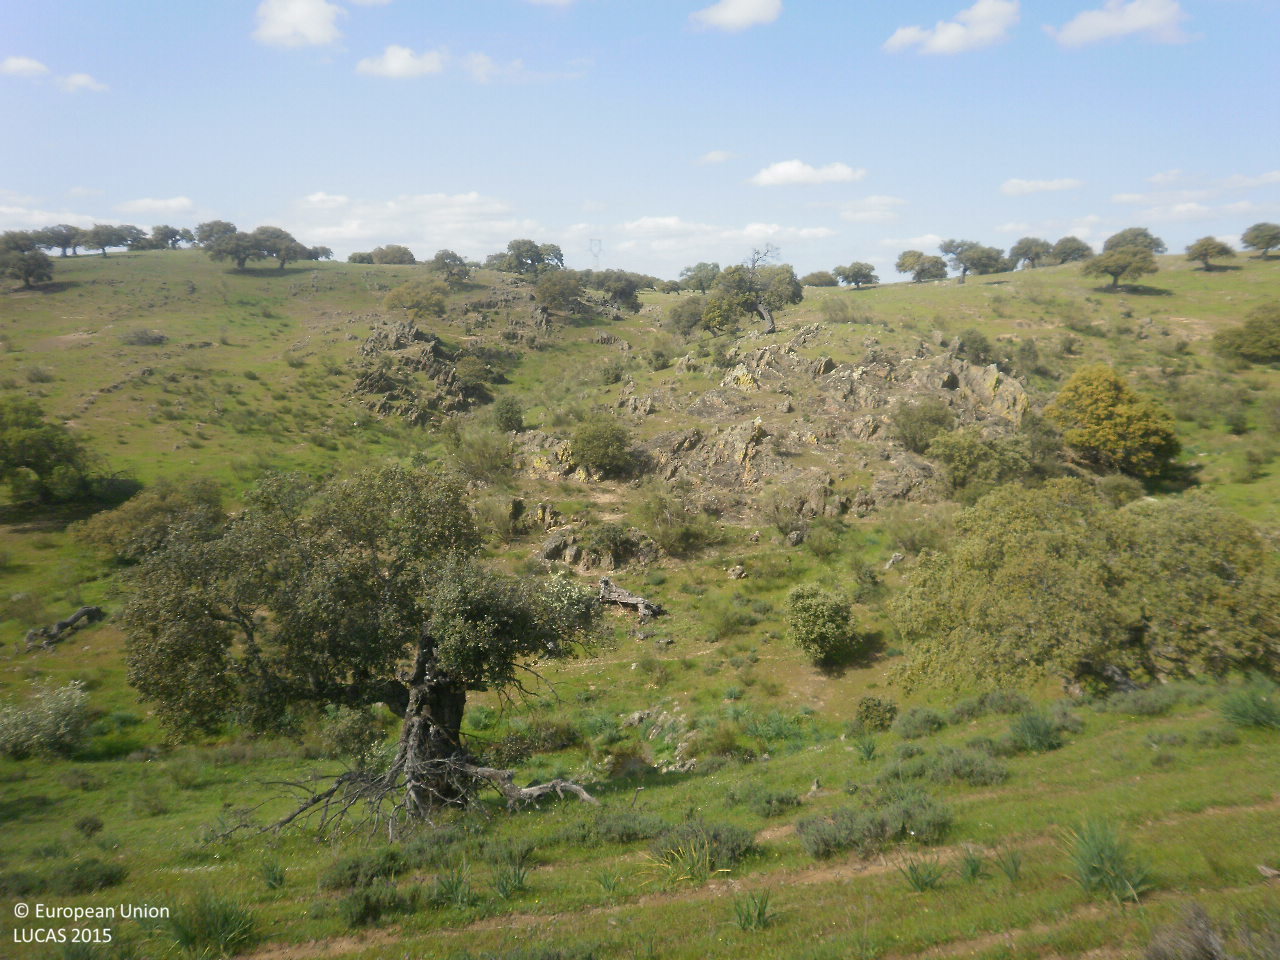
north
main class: Grassland
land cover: Grassland with sparse tree/shrub cover
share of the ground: > 75 %
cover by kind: herbaceous plants 85 %, shrubs 10 %, broadleaved forest trees 5 %
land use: Agriculture (excluding fallow land and kitchen gardens)
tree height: > 5 m
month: April
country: ES
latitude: 38.9876
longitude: -5.1733
